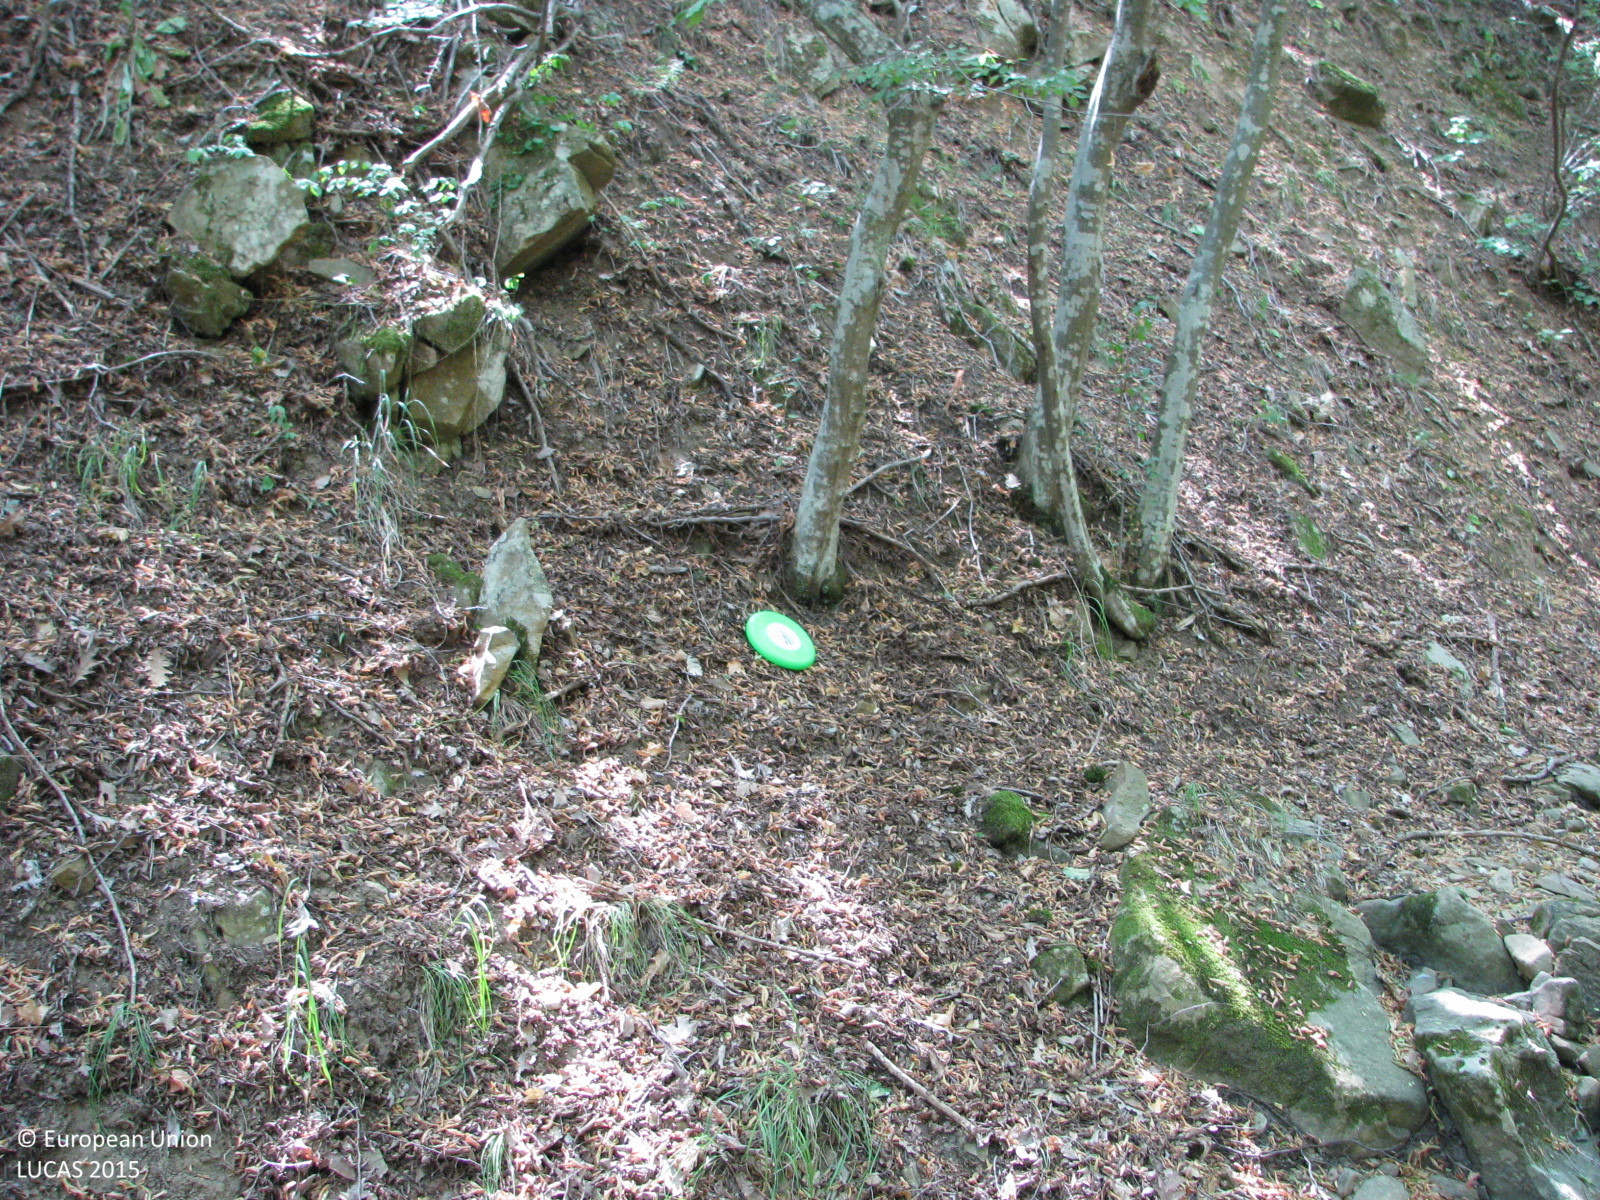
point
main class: Woodland
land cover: Broadleaved woodland
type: beech forest
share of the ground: 50 - 75 %
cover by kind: broadleaved forest trees 65 %, unconsolidated bare surface 25 %, herbaceous plants 10 %
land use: Forestry
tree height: > 5 m
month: August
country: BG
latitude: 42.7540
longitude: 26.6548
